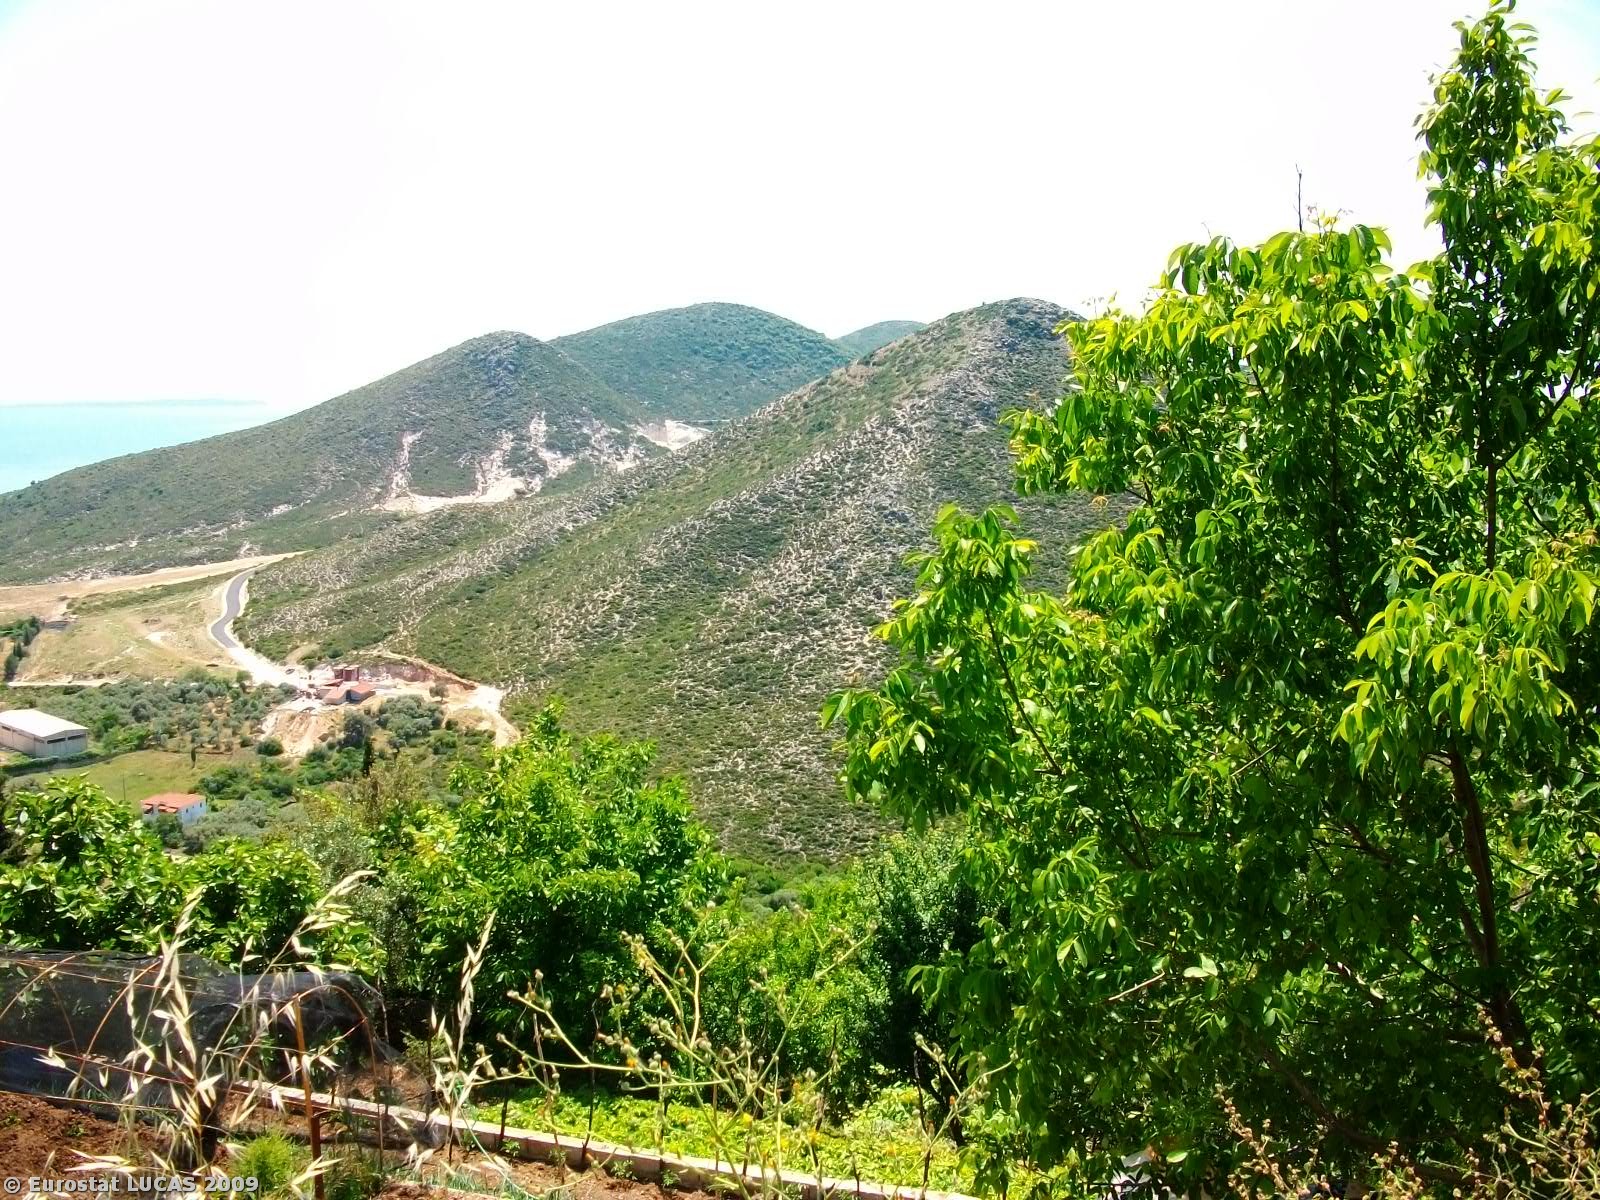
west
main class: Grassland
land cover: Grassland with sparse tree/shrub cover
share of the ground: > 75 %
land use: Unused
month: June
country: GR
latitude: 39.3169
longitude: 20.3531
